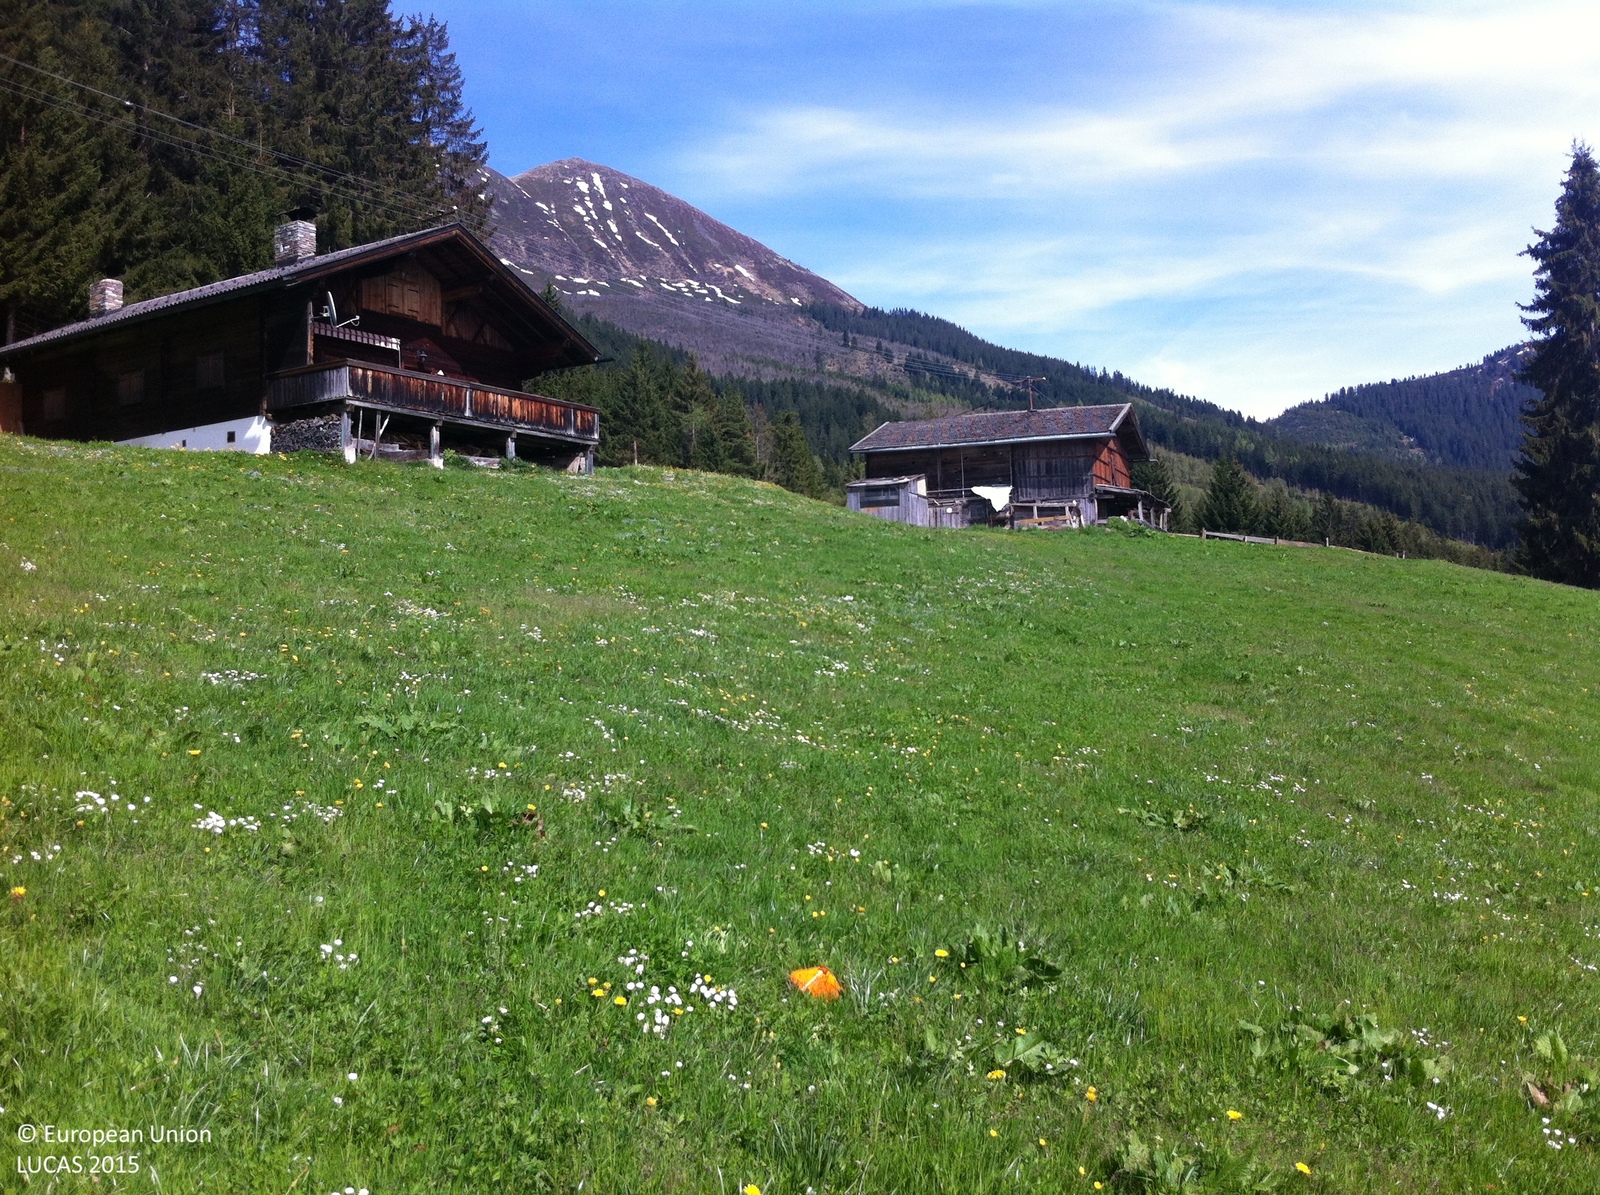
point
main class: Grassland
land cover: Grassland without tree/shrub cover
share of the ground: > 75 %
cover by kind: herbaceous plants 100 %
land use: Agriculture (excluding fallow land and kitchen gardens)
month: May
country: AT
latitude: 47.3098
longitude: 11.7313
